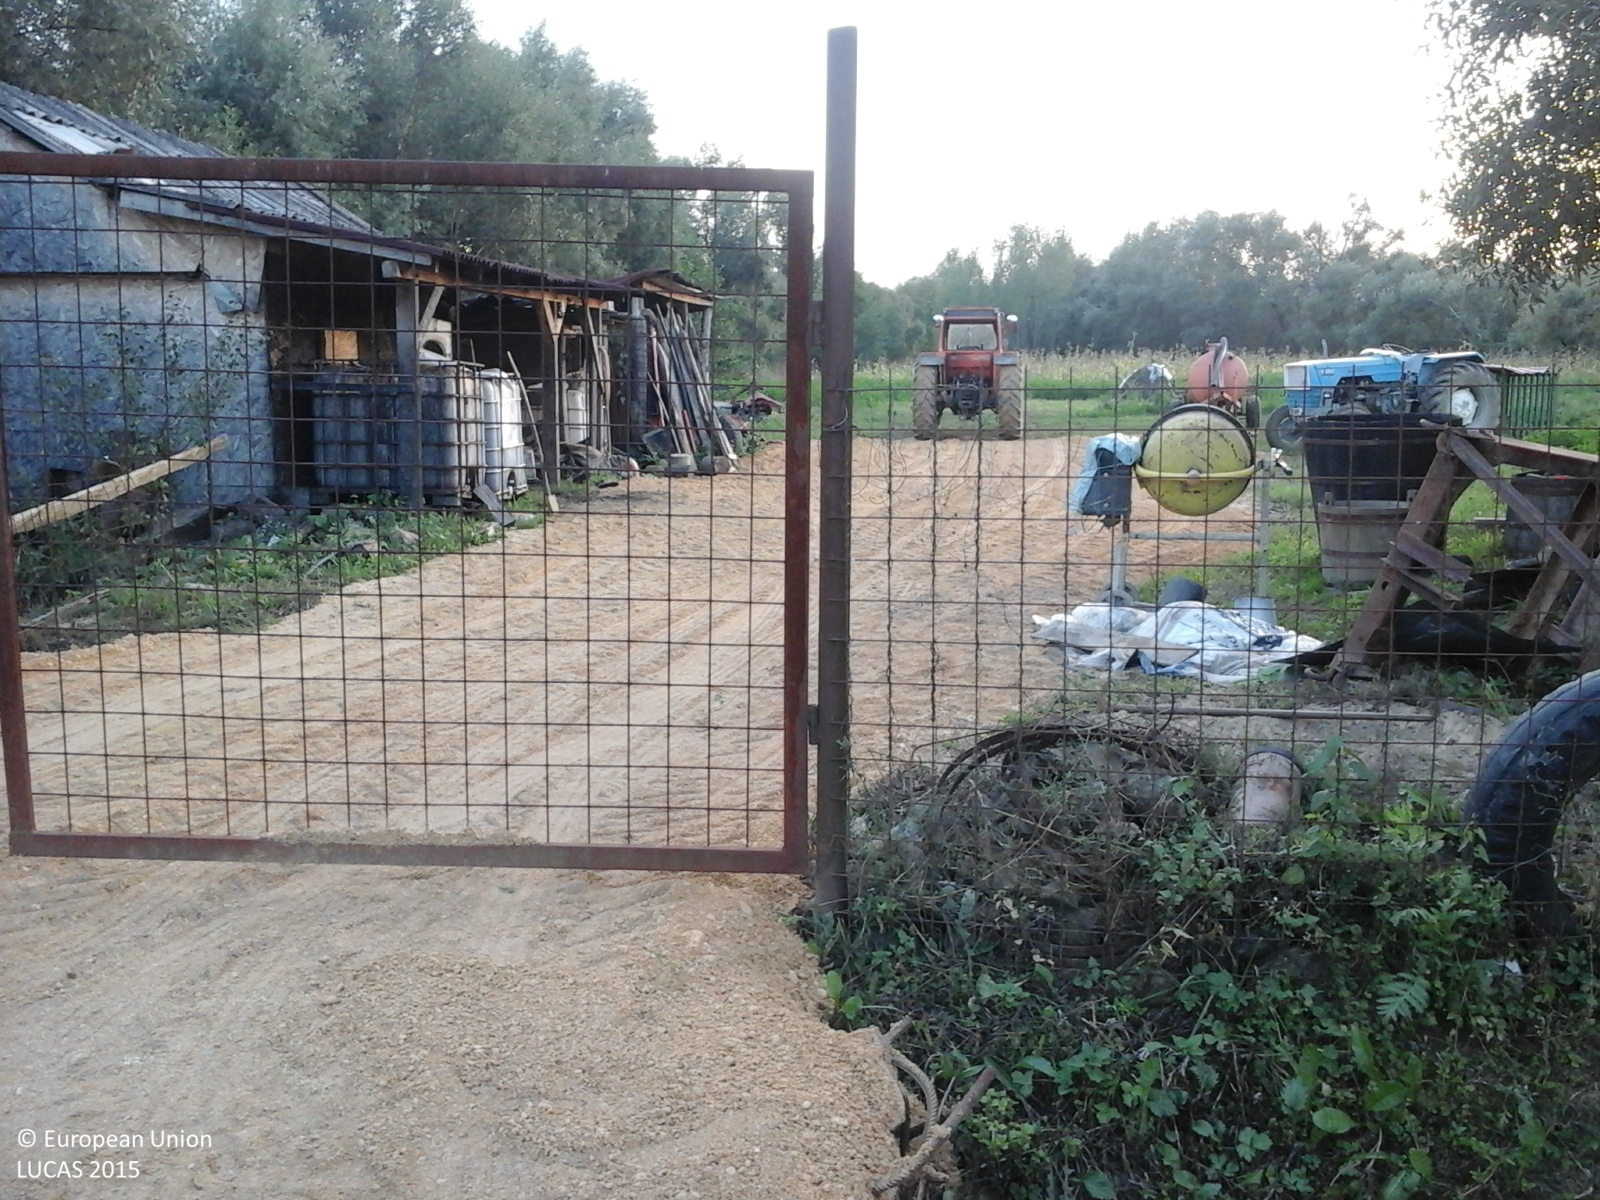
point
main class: Cropland
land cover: Maize
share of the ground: > 75 %
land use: Agriculture (excluding fallow land and kitchen gardens)
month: September
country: RO
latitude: 47.1629
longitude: 22.6552
